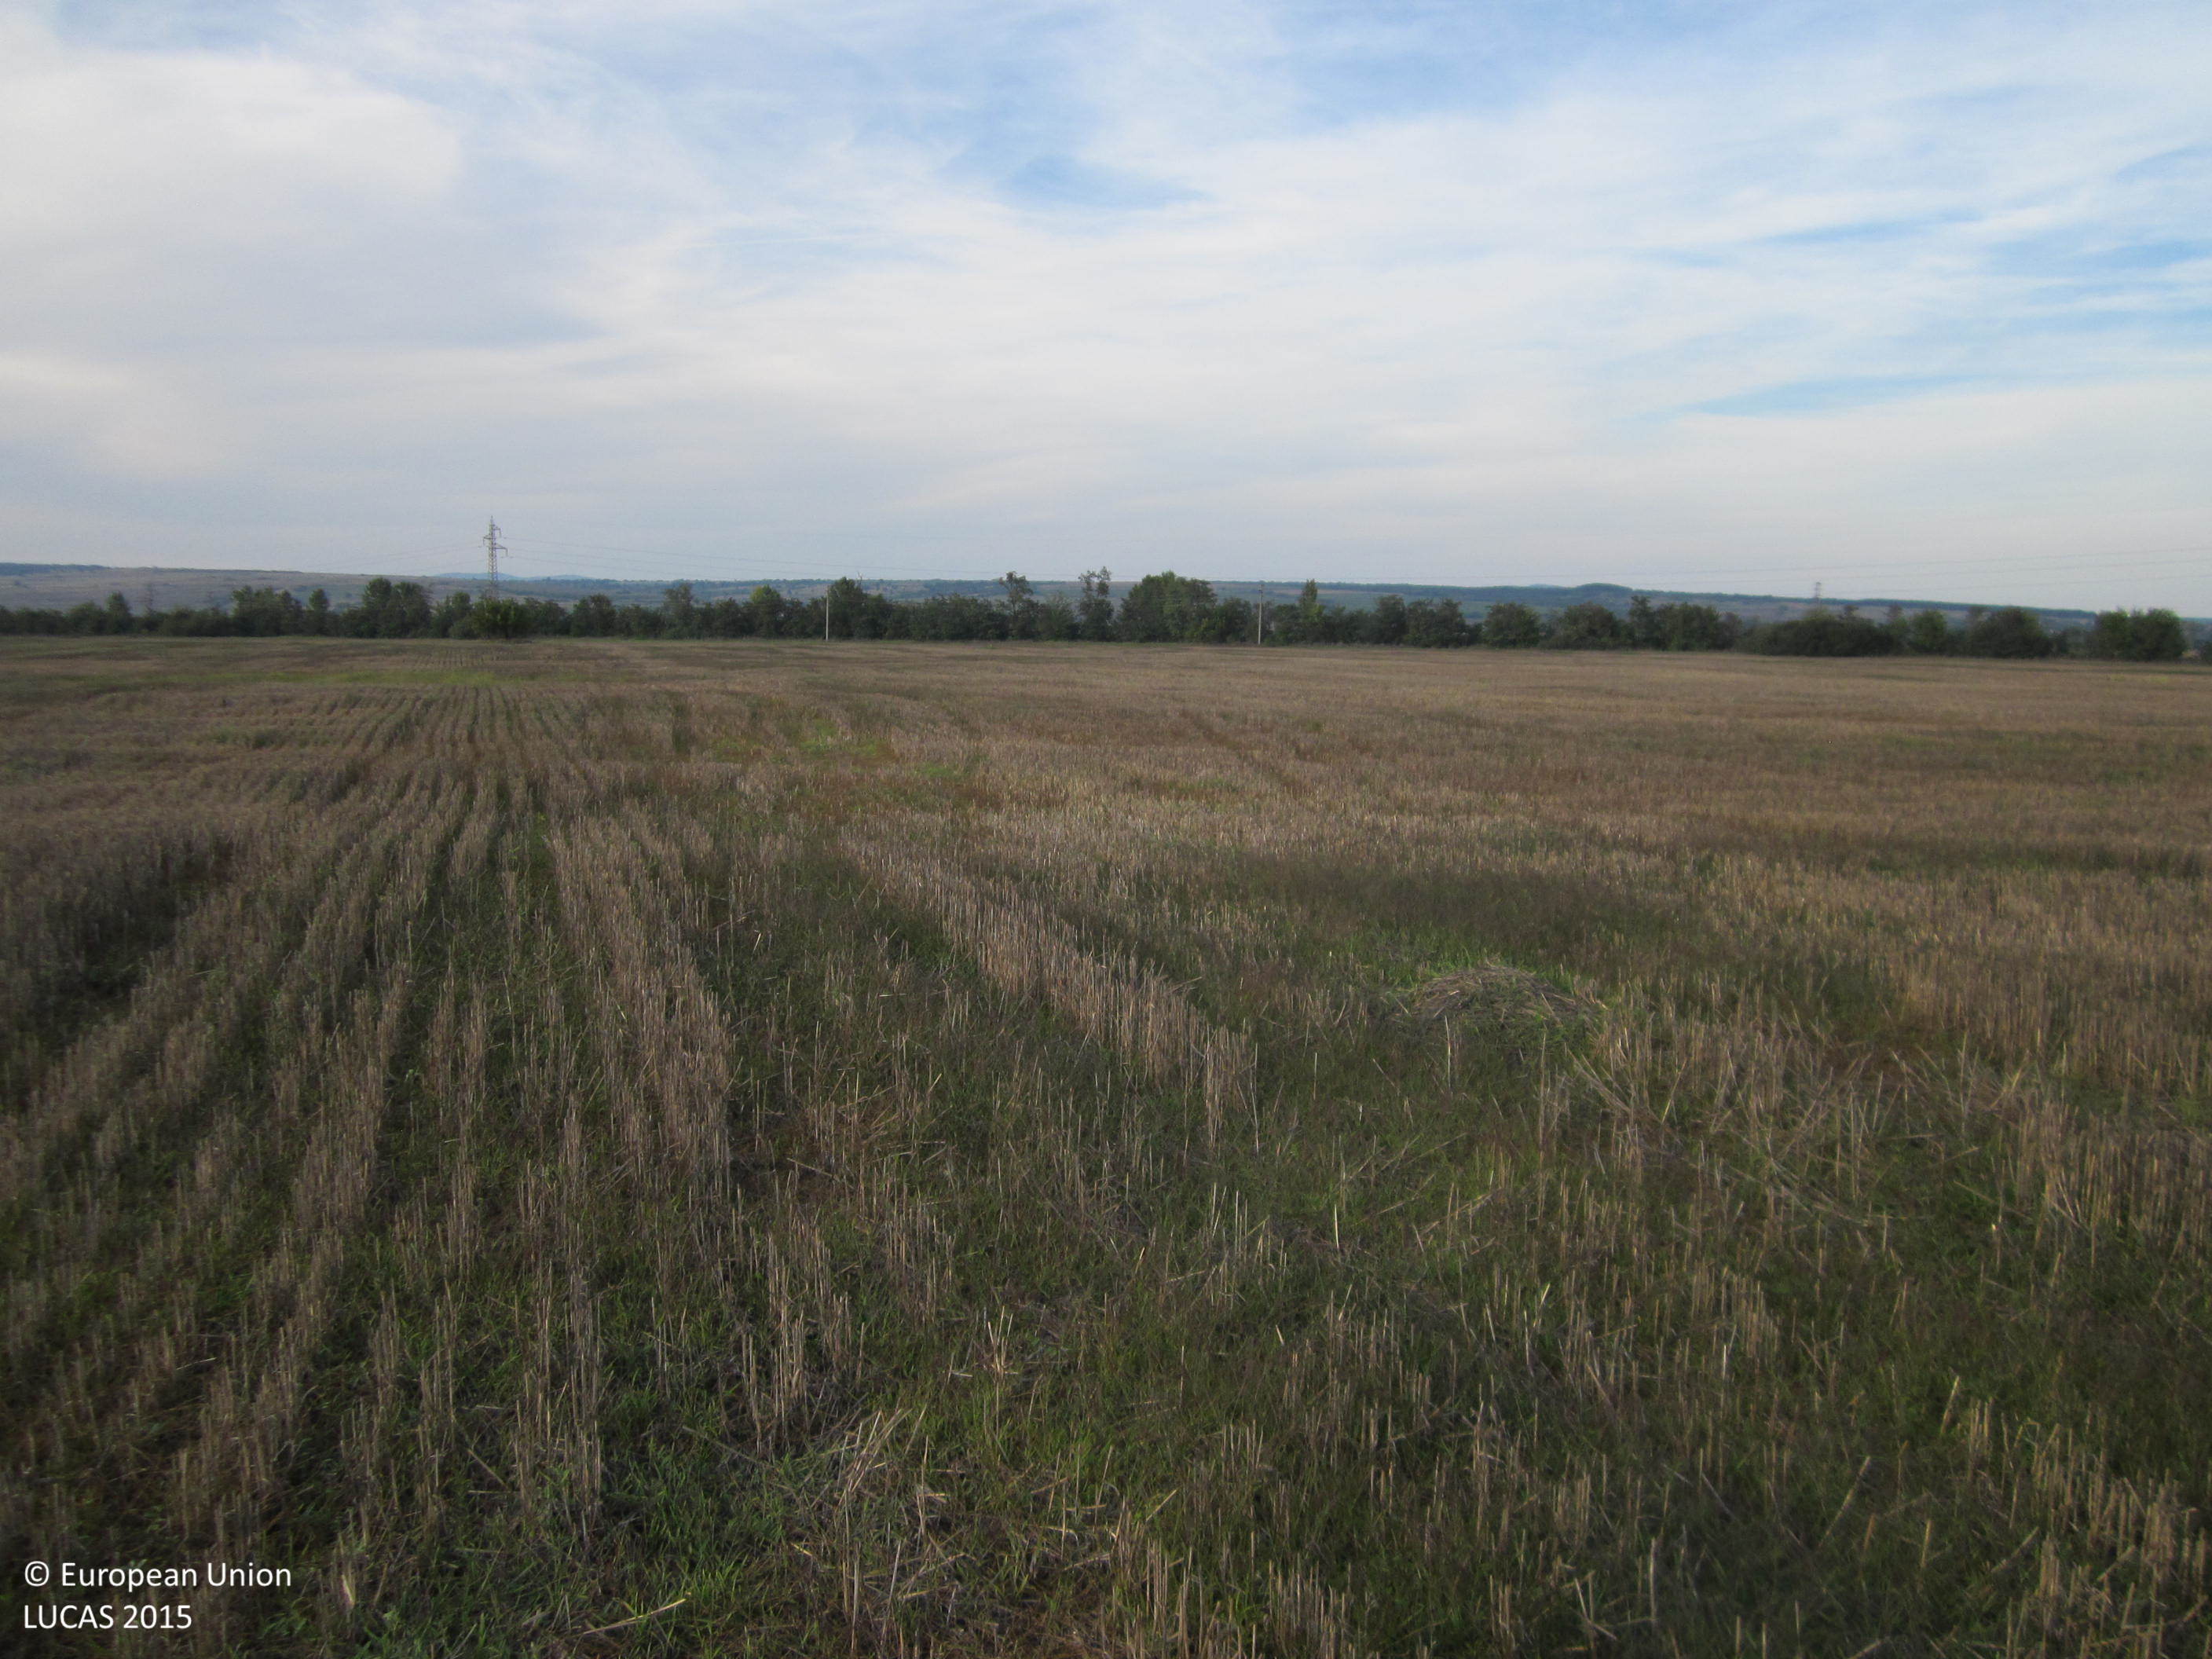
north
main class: Cropland
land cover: Common wheat
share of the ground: 50 - 75 %
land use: Agriculture (excluding fallow land and kitchen gardens)
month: October
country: BG
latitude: 42.7475
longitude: 26.8033
